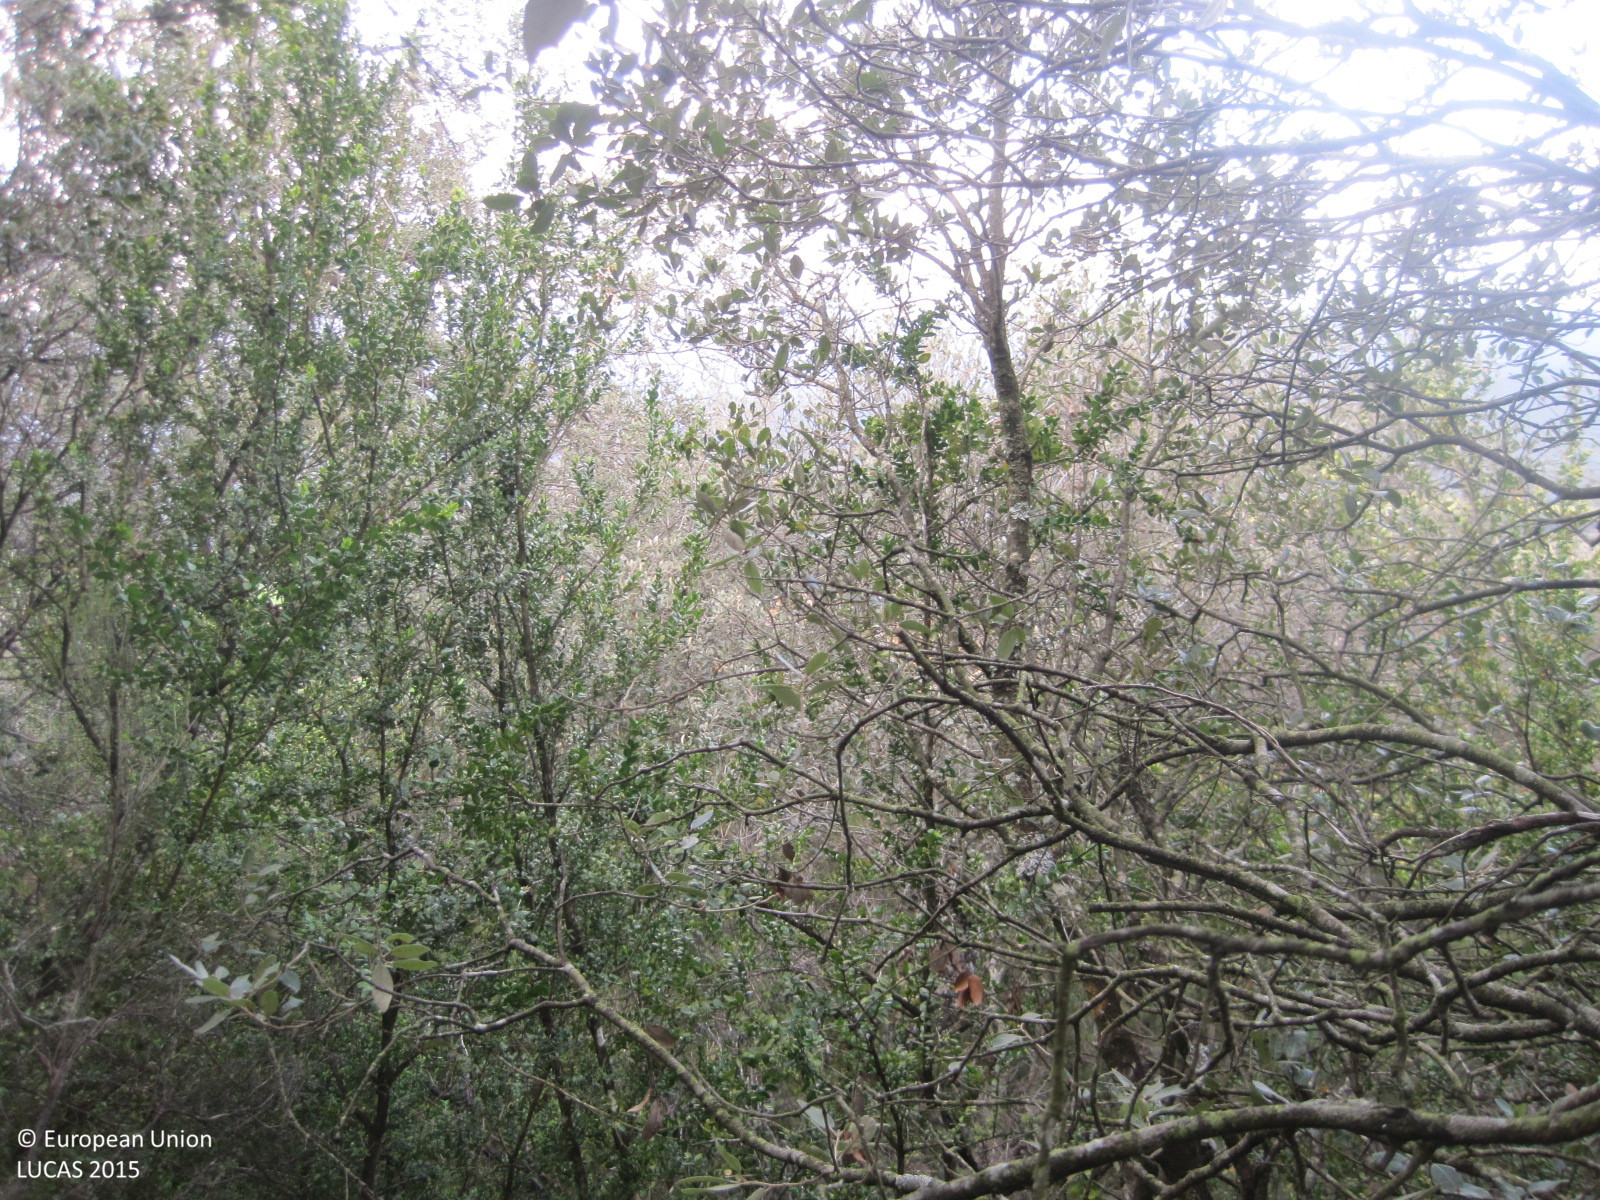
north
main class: Woodland
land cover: Broadleaved woodland
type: acidophilous oak and oak-birch forest
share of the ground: > 75 %
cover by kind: broadleaved forest trees 100 %
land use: Forestry
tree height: > 5 m
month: April
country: ES
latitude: 42.6577
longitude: -2.2311
